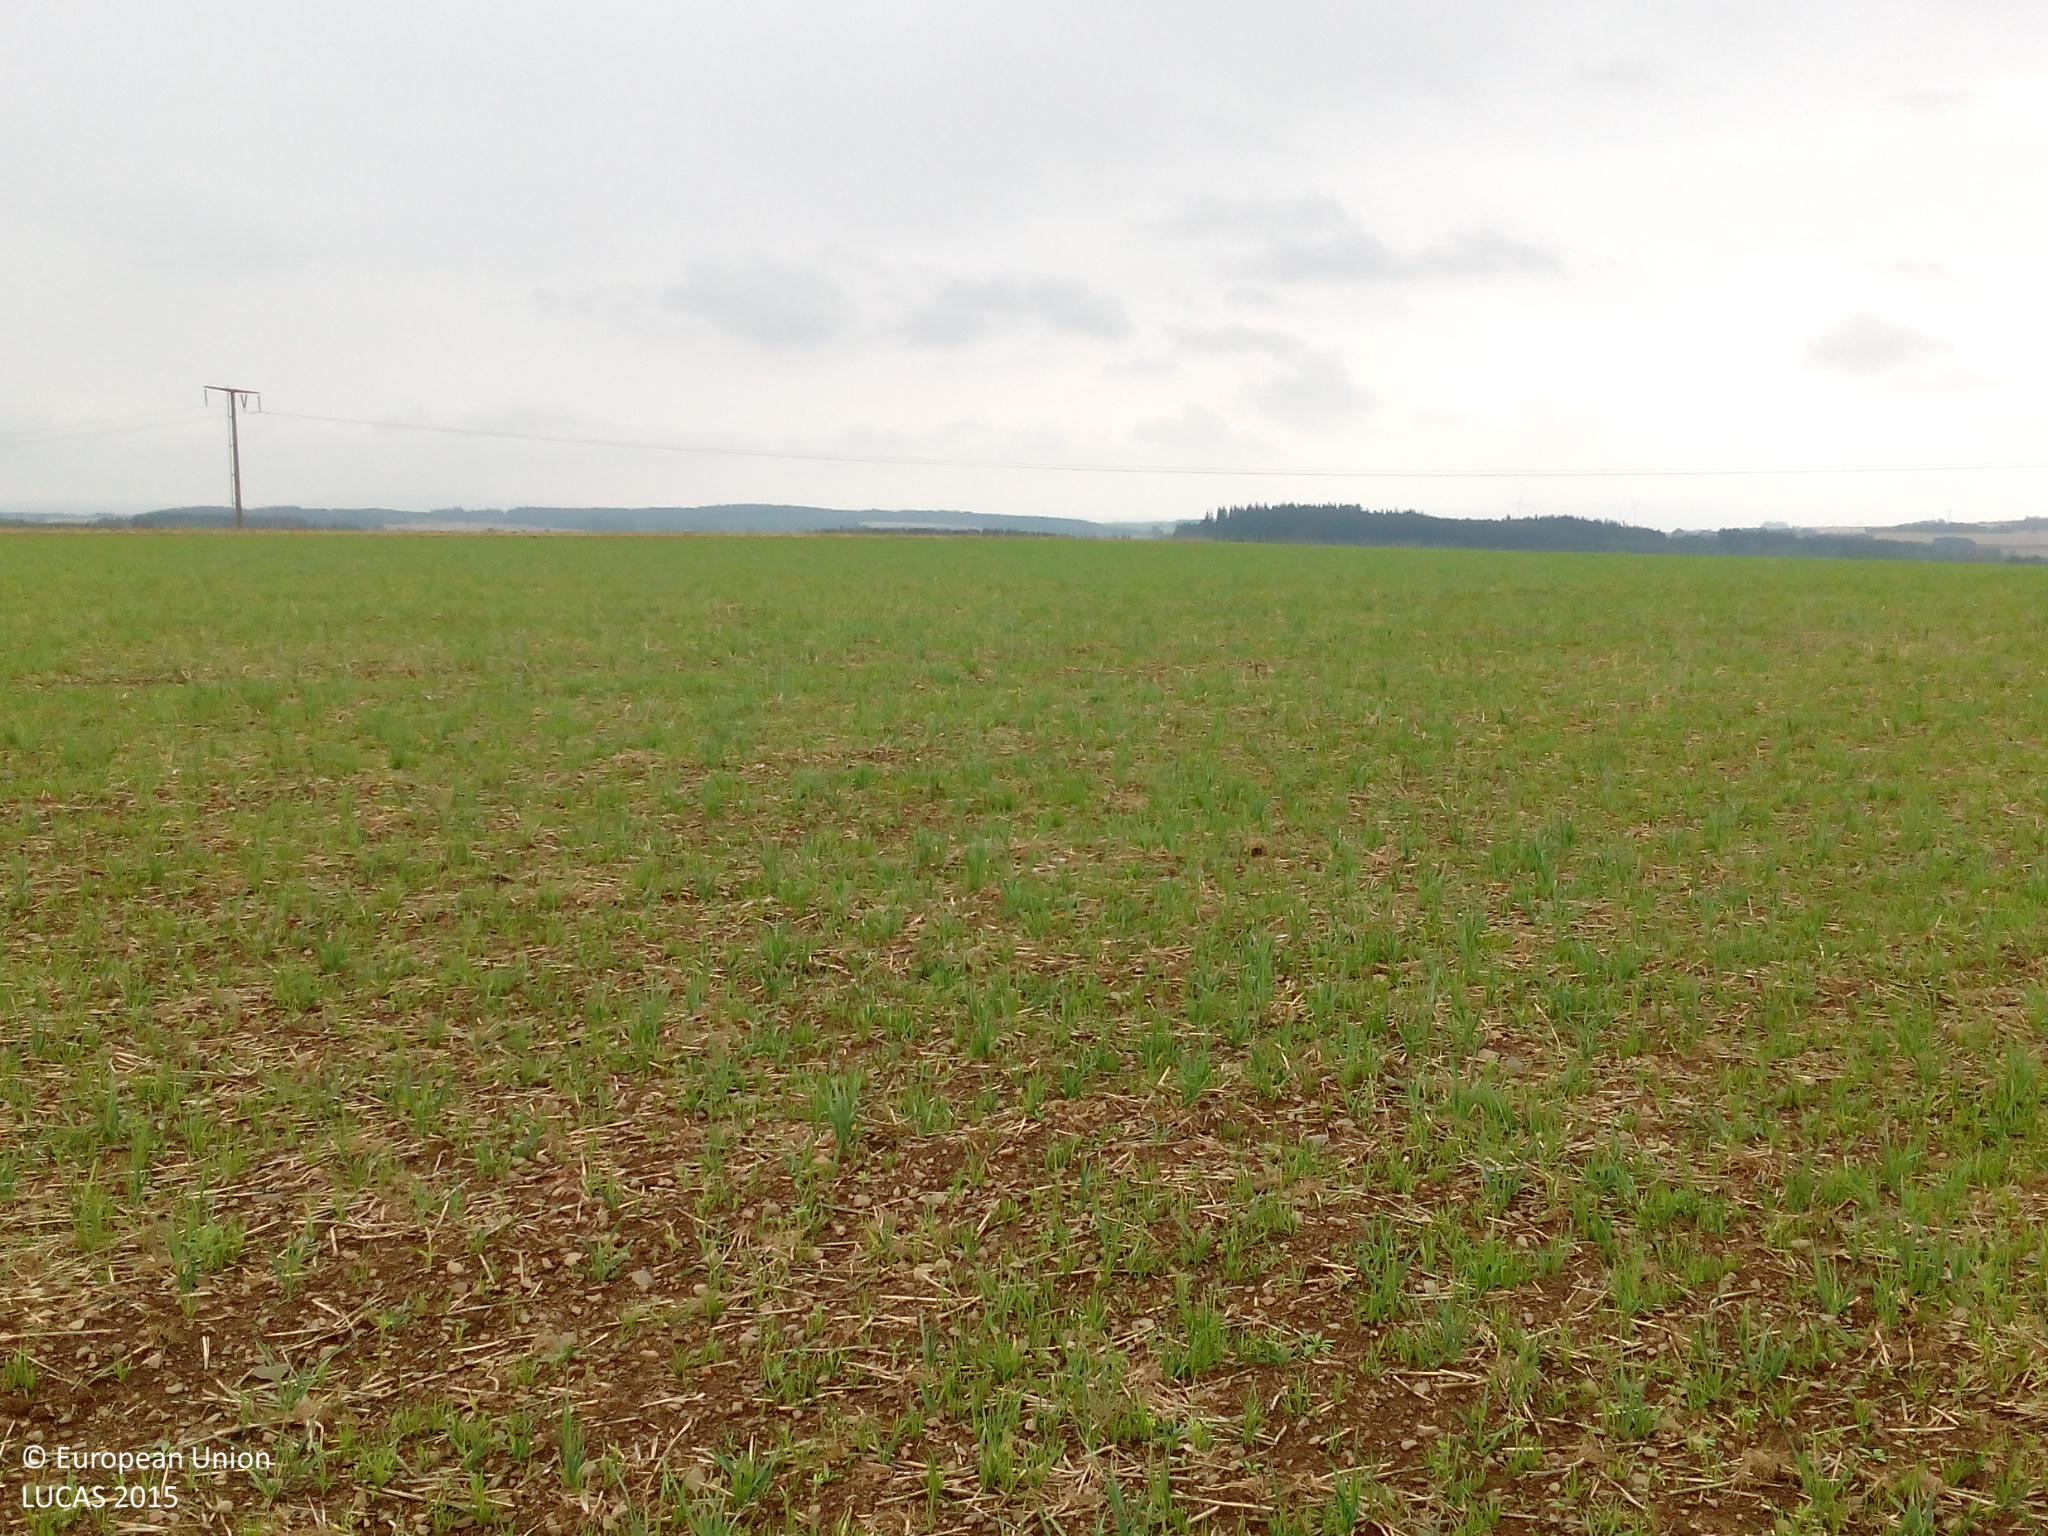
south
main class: Cropland
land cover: Common wheat
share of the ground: 25 - 50 %
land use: Agriculture (excluding fallow land and kitchen gardens)
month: August
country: DE
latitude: 50.3110
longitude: 11.9796
